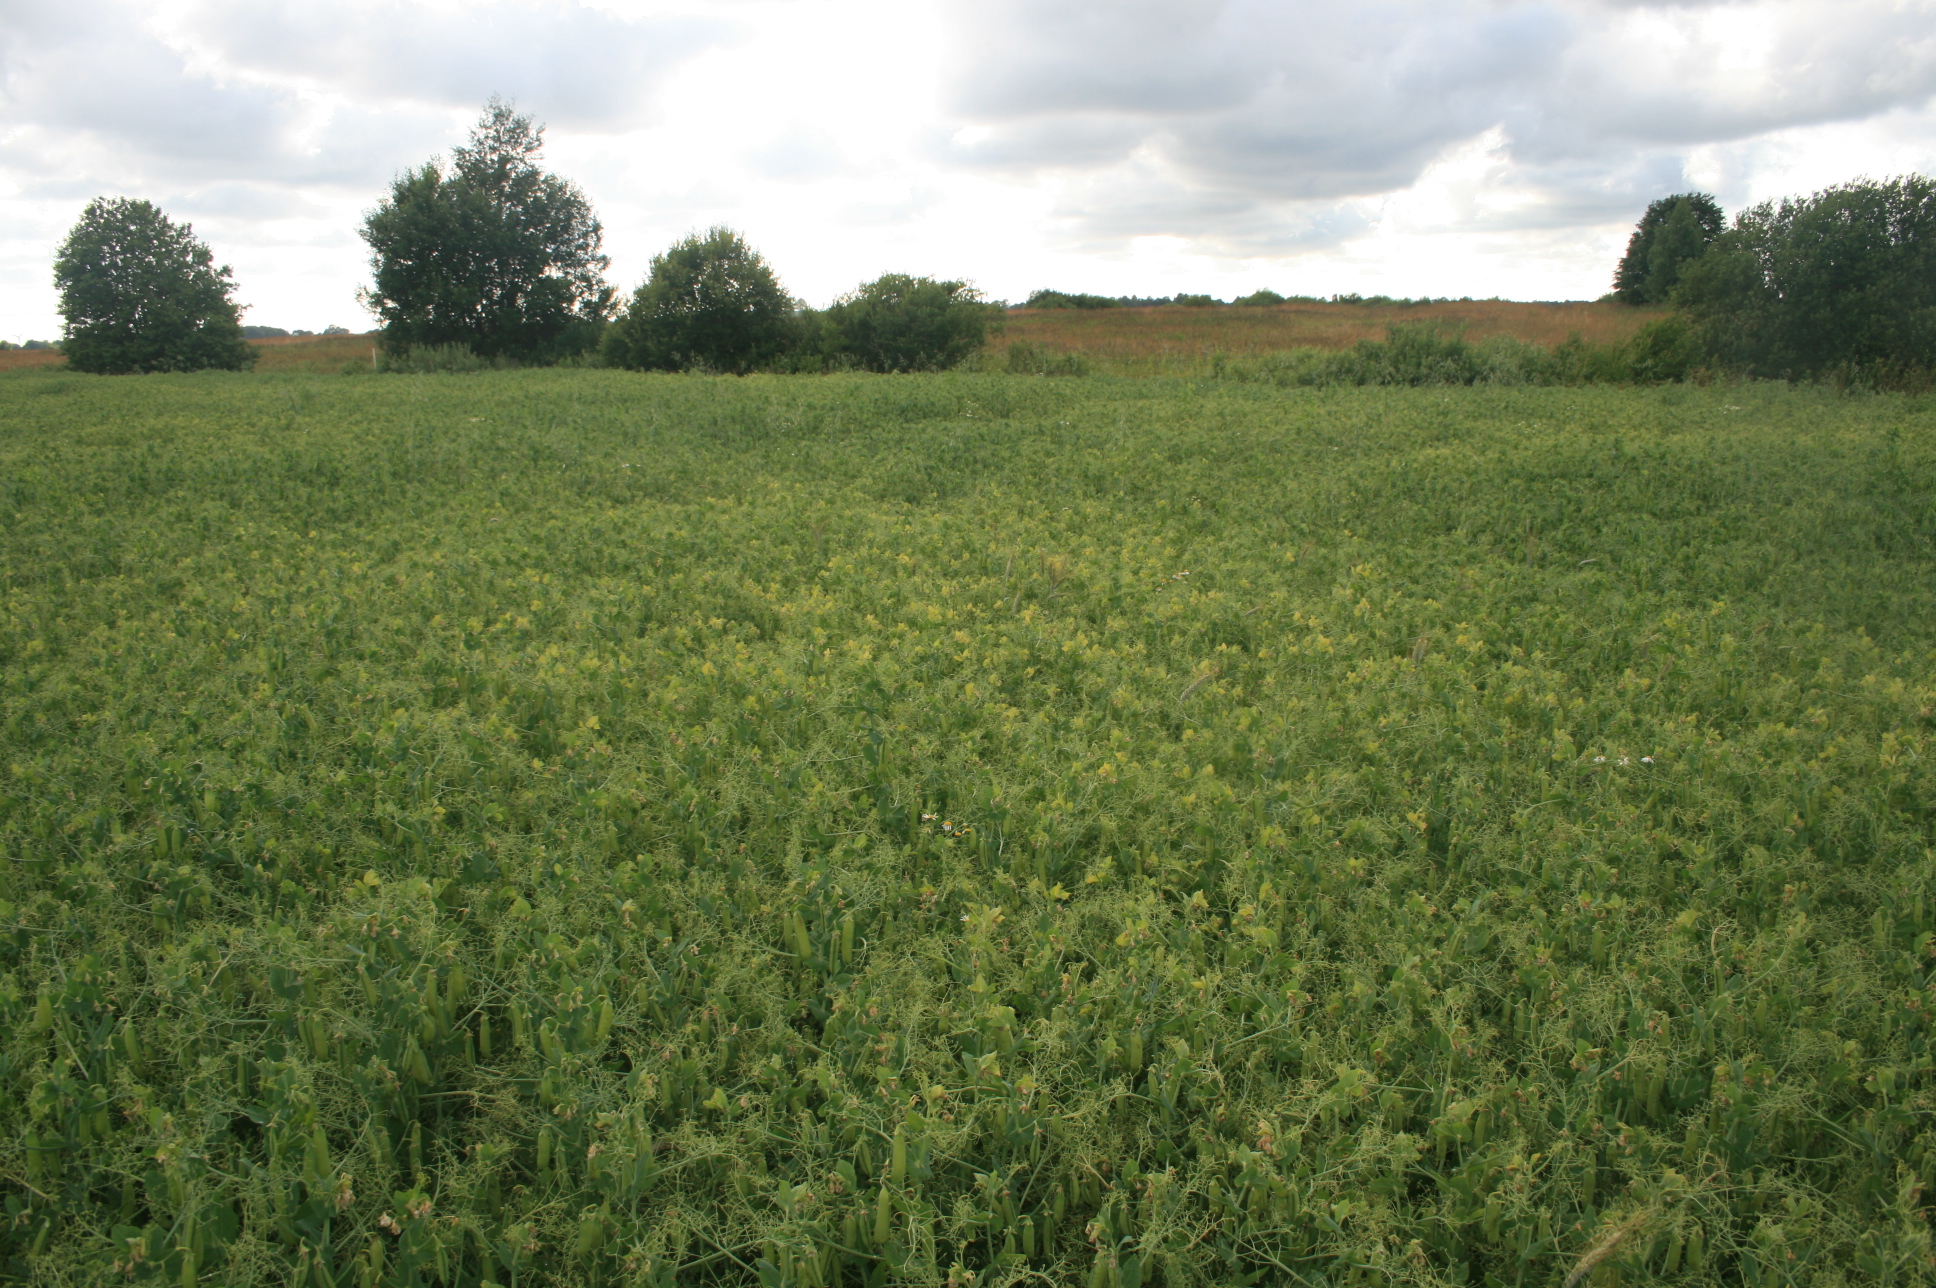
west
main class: Cropland
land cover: Dry pulses
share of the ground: > 75 %
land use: Agriculture (excluding fallow land and kitchen gardens)
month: July
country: LT
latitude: 55.9416
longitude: 21.2970
